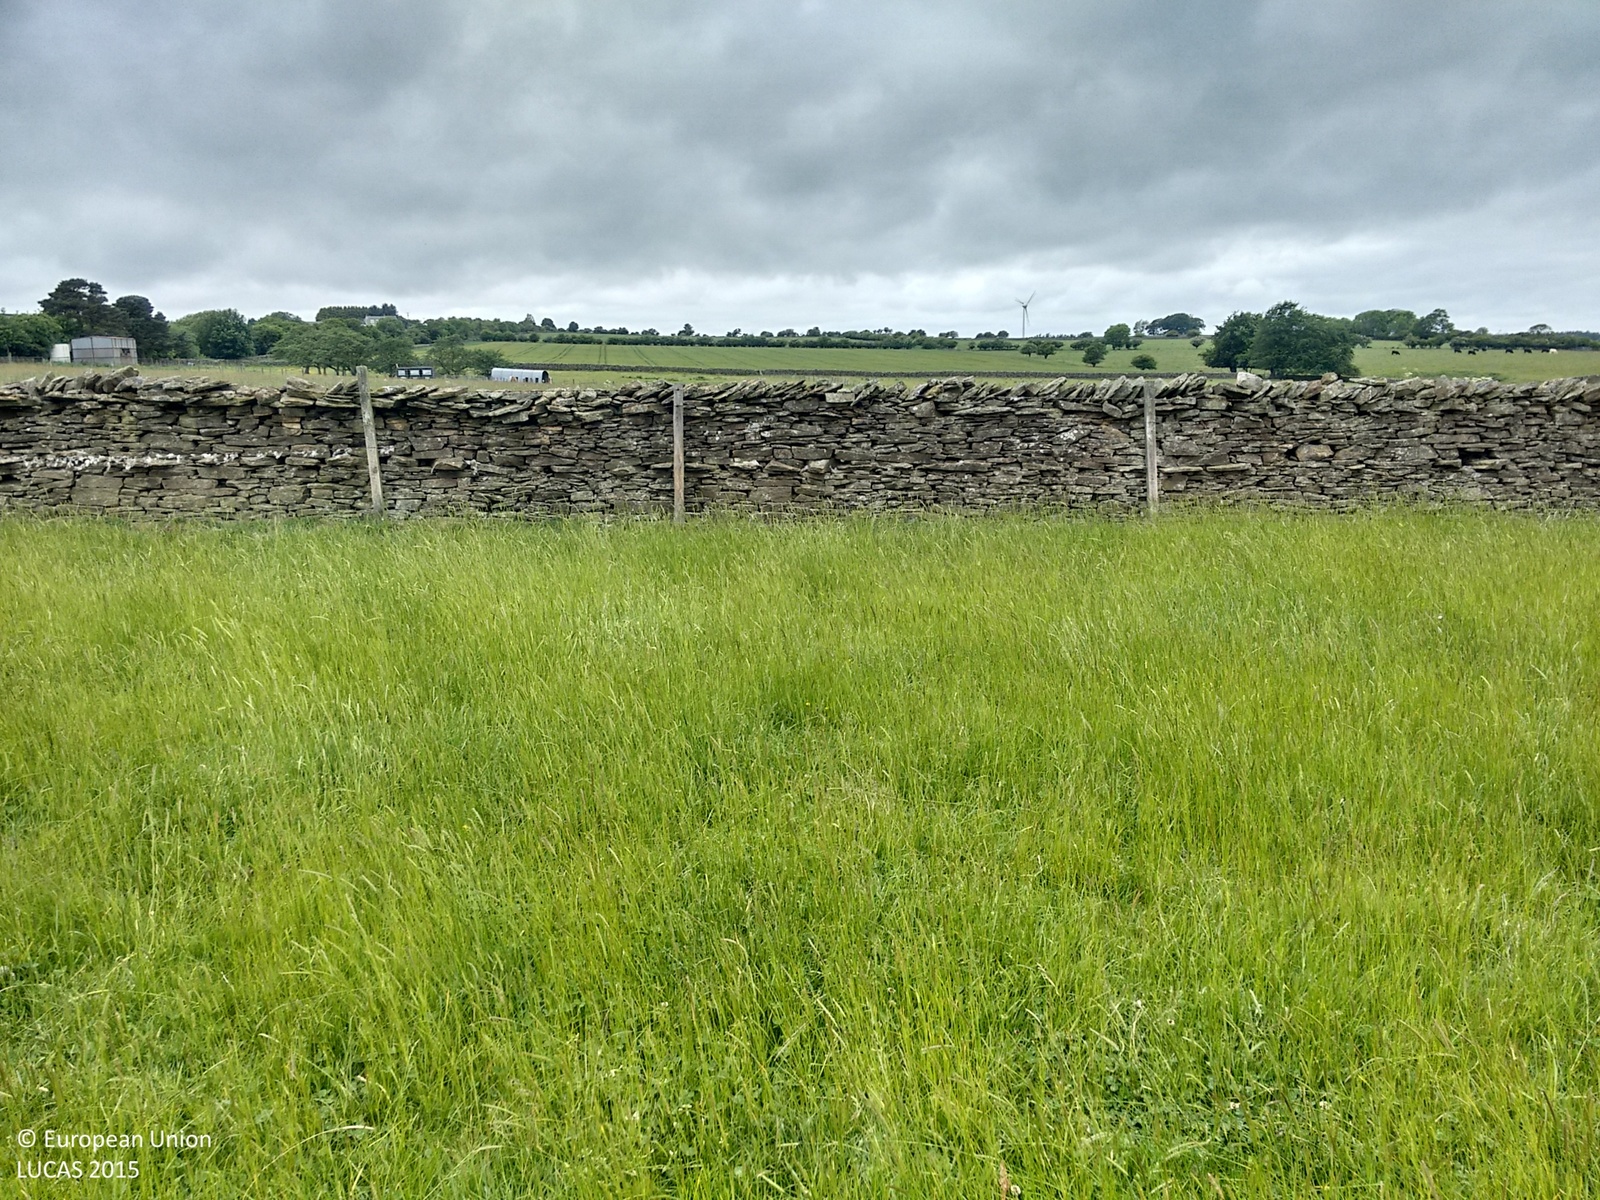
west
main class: Grassland
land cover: Grassland without tree/shrub cover
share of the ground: > 75 %
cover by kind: herbaceous plants 100 %
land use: Agriculture (excluding fallow land and kitchen gardens)
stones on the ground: < 10 %
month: June
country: GB
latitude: 54.8194
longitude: -1.8338
